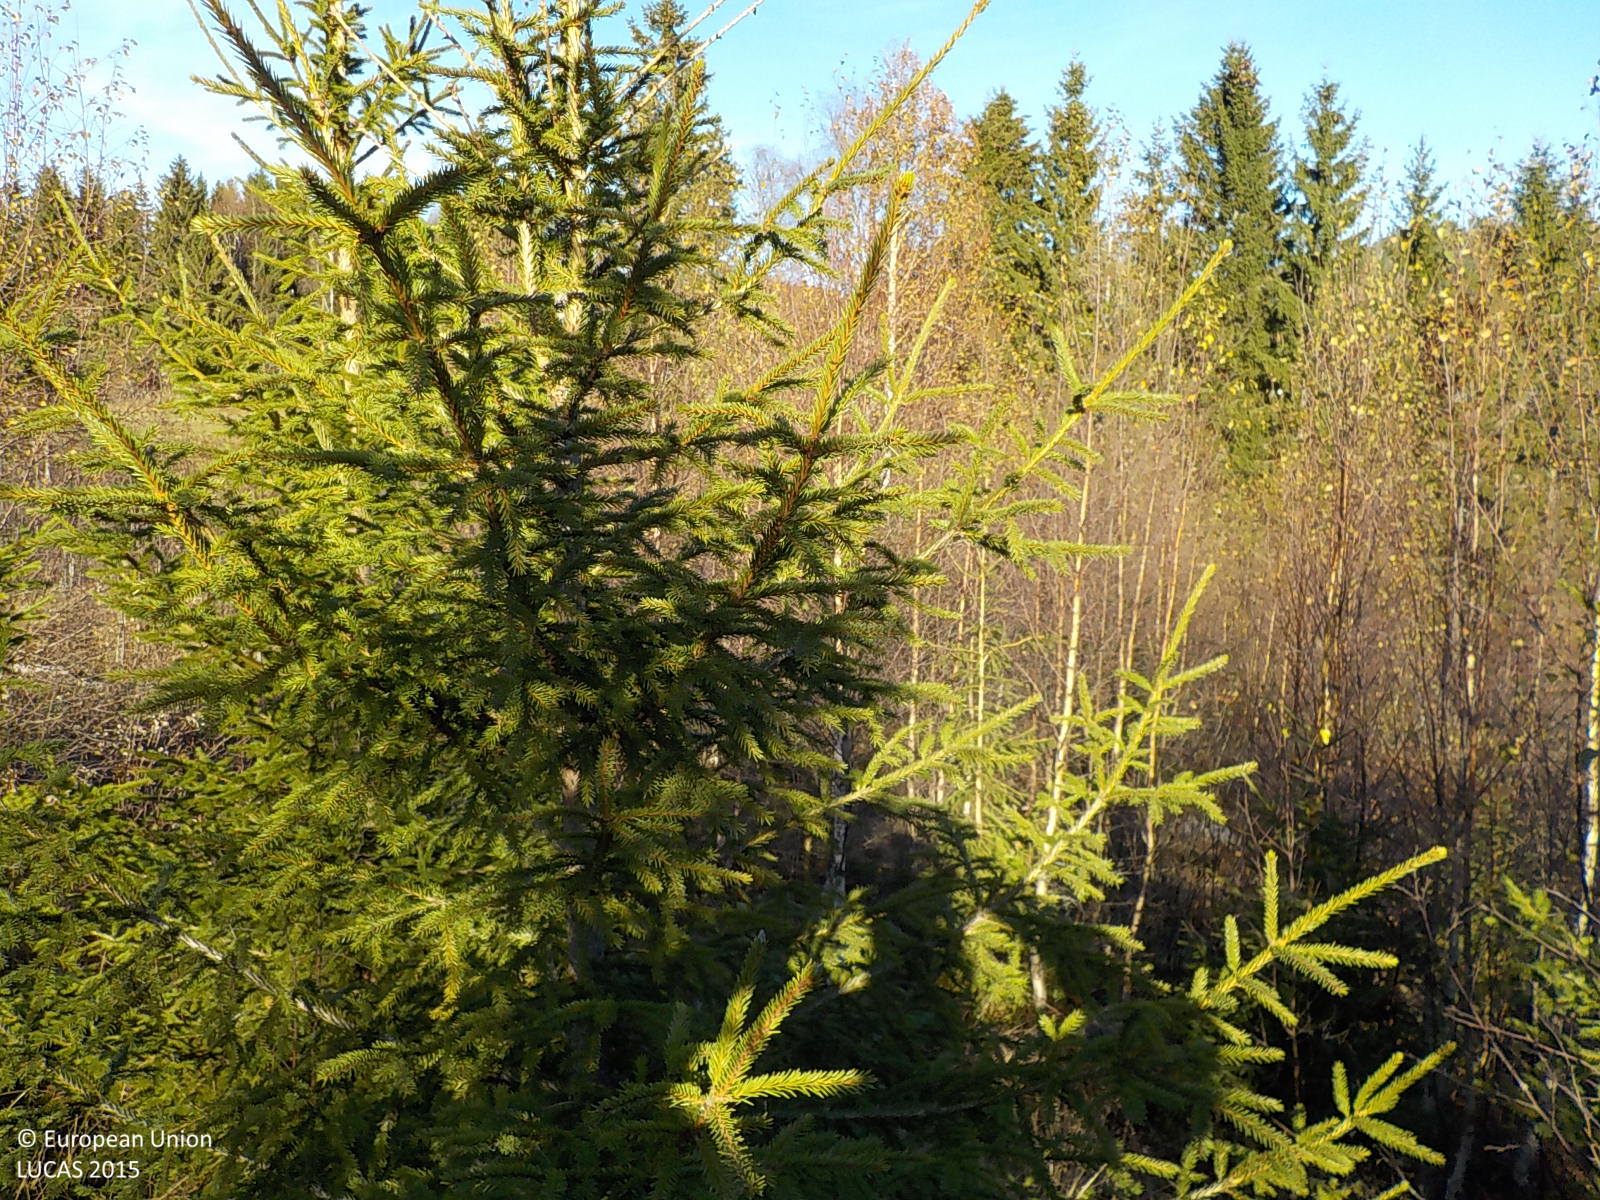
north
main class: Woodland
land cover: Spruce dominated mixed woodland
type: boreal forest
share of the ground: 50 - 75 %
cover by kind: coniferous forest trees 35 %, broadleaved forest trees 35 %, shrubs 30 %
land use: Forestry
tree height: < 5 m
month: October
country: SE
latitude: 63.0386
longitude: 18.2621
